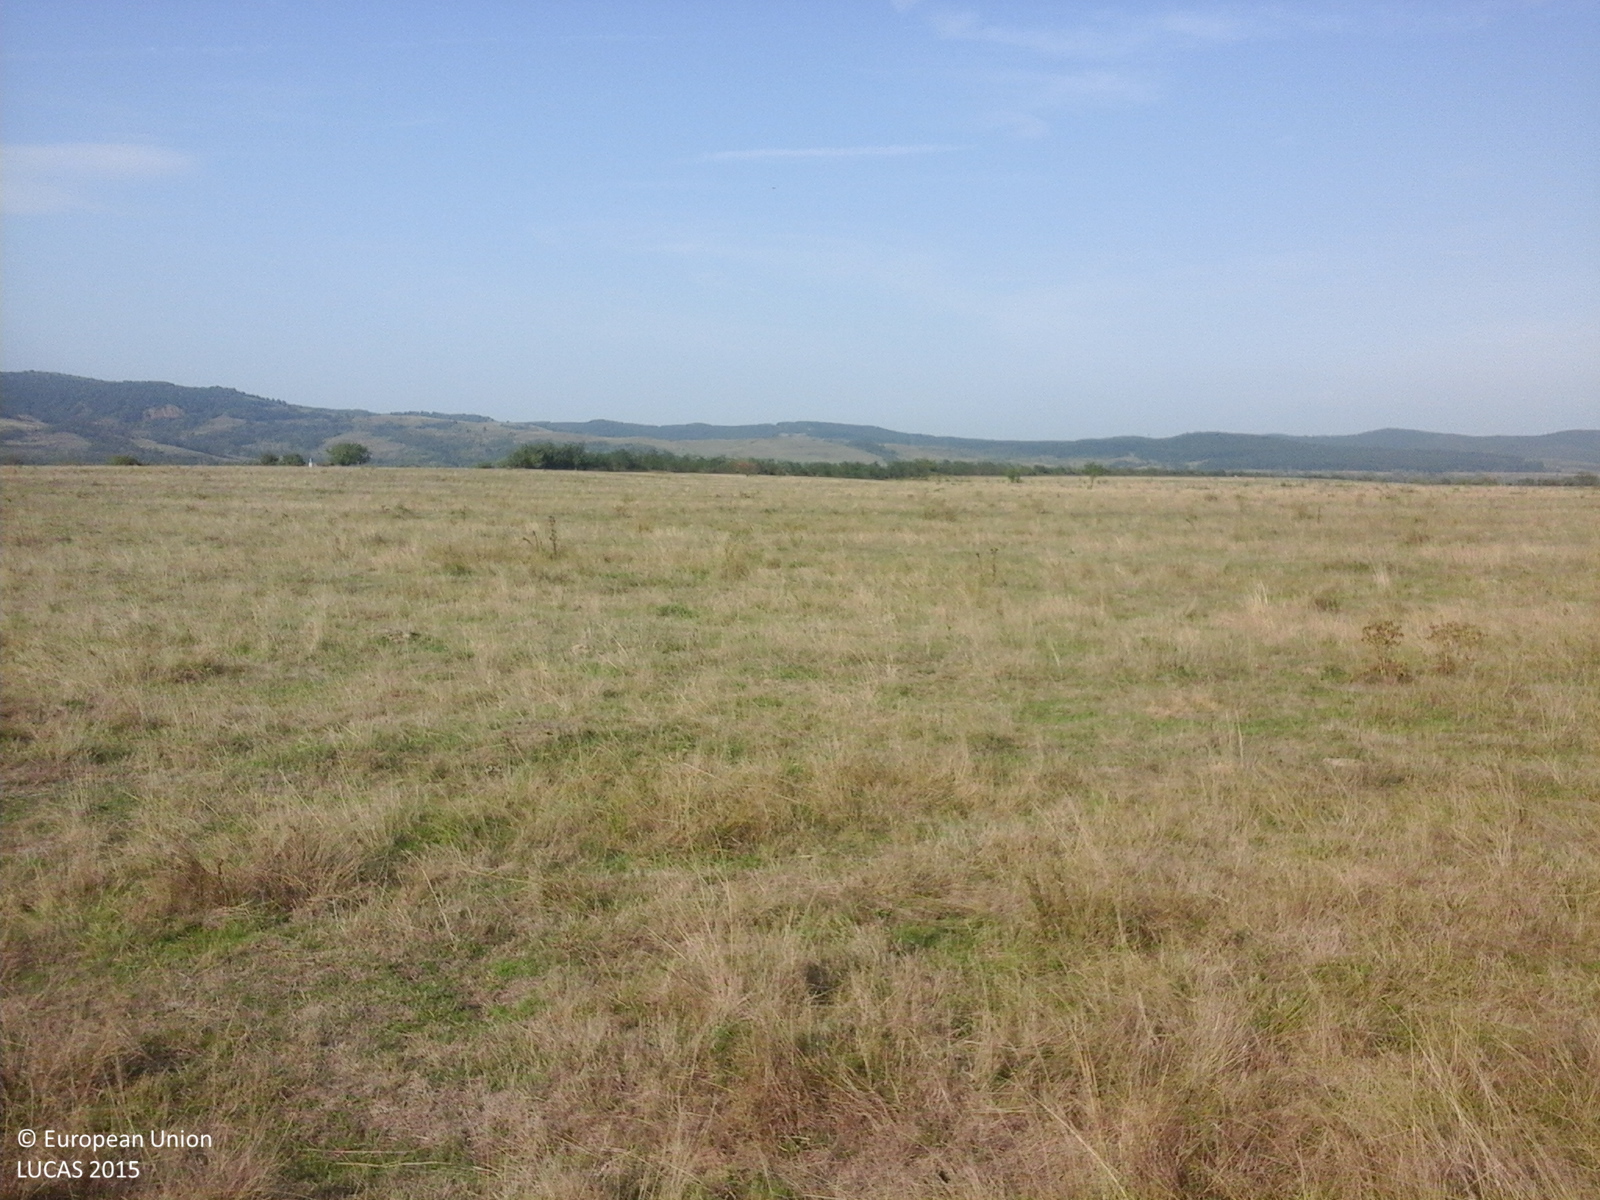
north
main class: Grassland
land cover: Grassland without tree/shrub cover
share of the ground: > 75 %
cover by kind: herbaceous plants 100 %
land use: Agriculture (excluding fallow land and kitchen gardens)
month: September
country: RO
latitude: 45.5867
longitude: 22.8818
